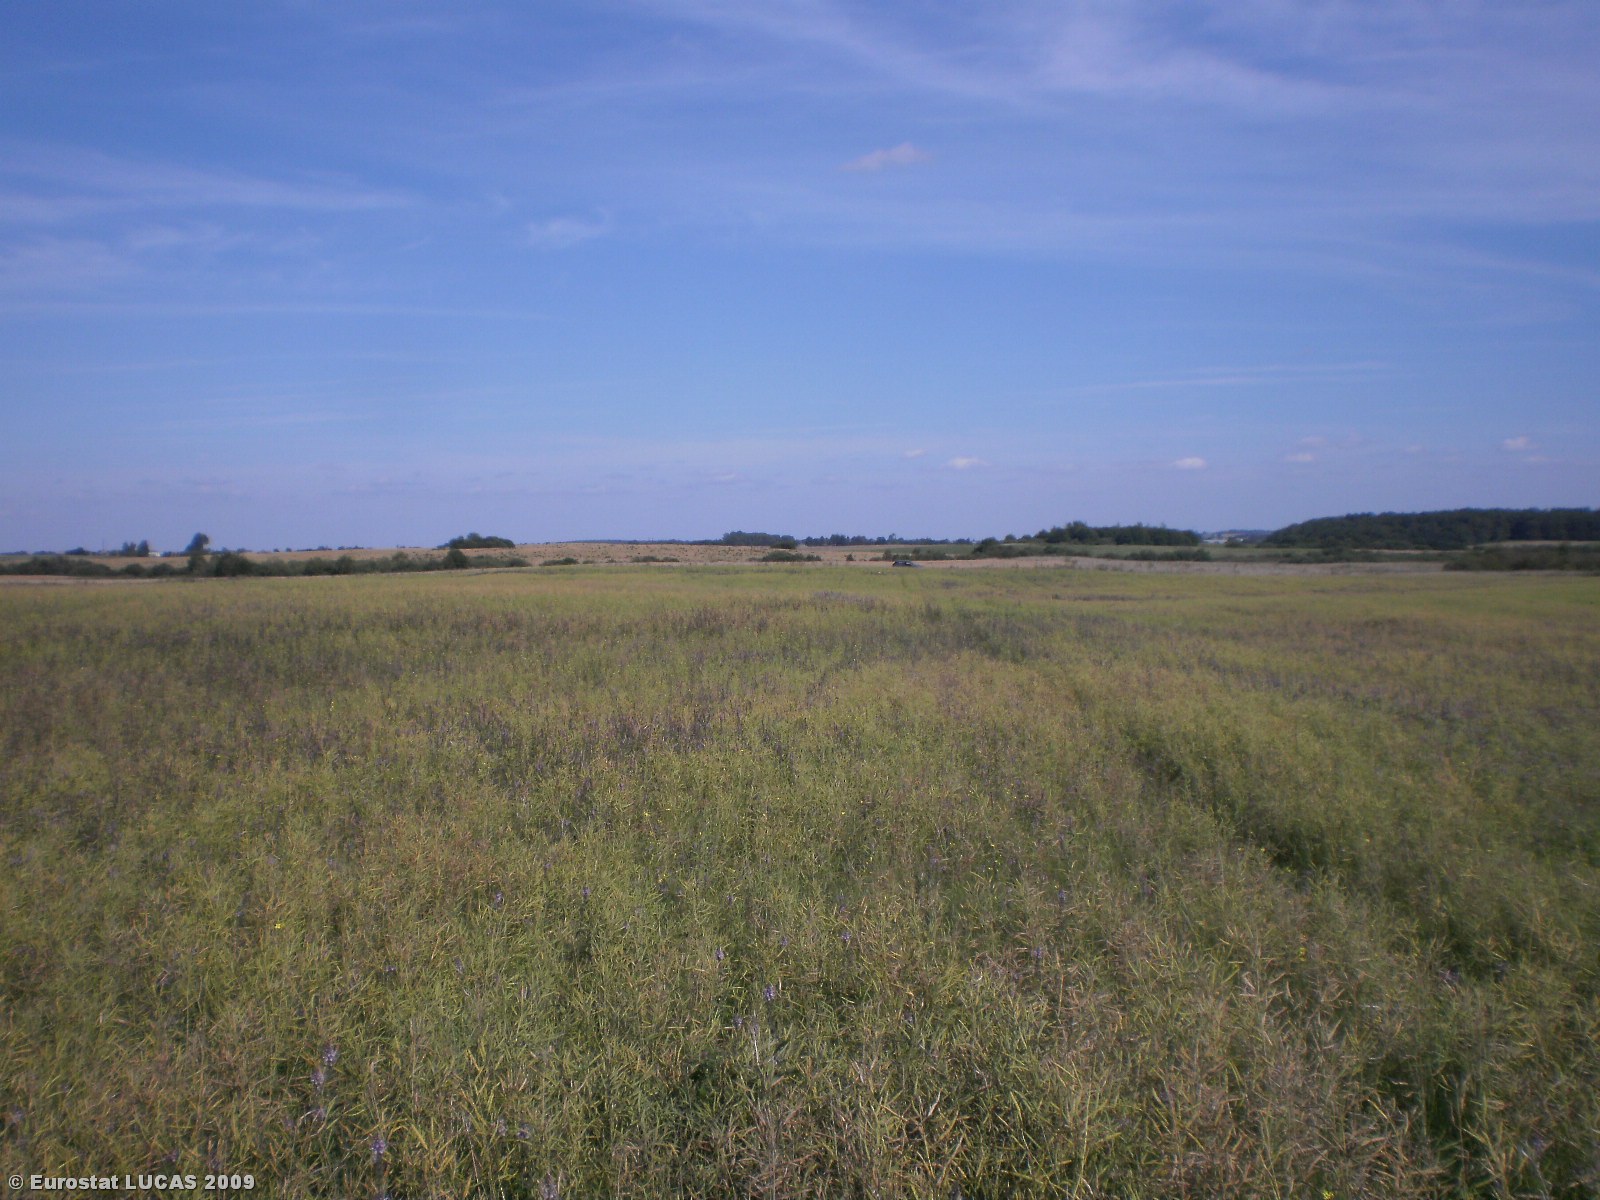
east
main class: Cropland
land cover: Rape and turnip rape
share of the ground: > 75 %
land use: Agriculture (excluding fallow land and kitchen gardens)
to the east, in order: Rape and turnip rape; Tracks; Grassland without tree/shrub cover
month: August
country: LT
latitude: 54.8937
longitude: 24.5569
